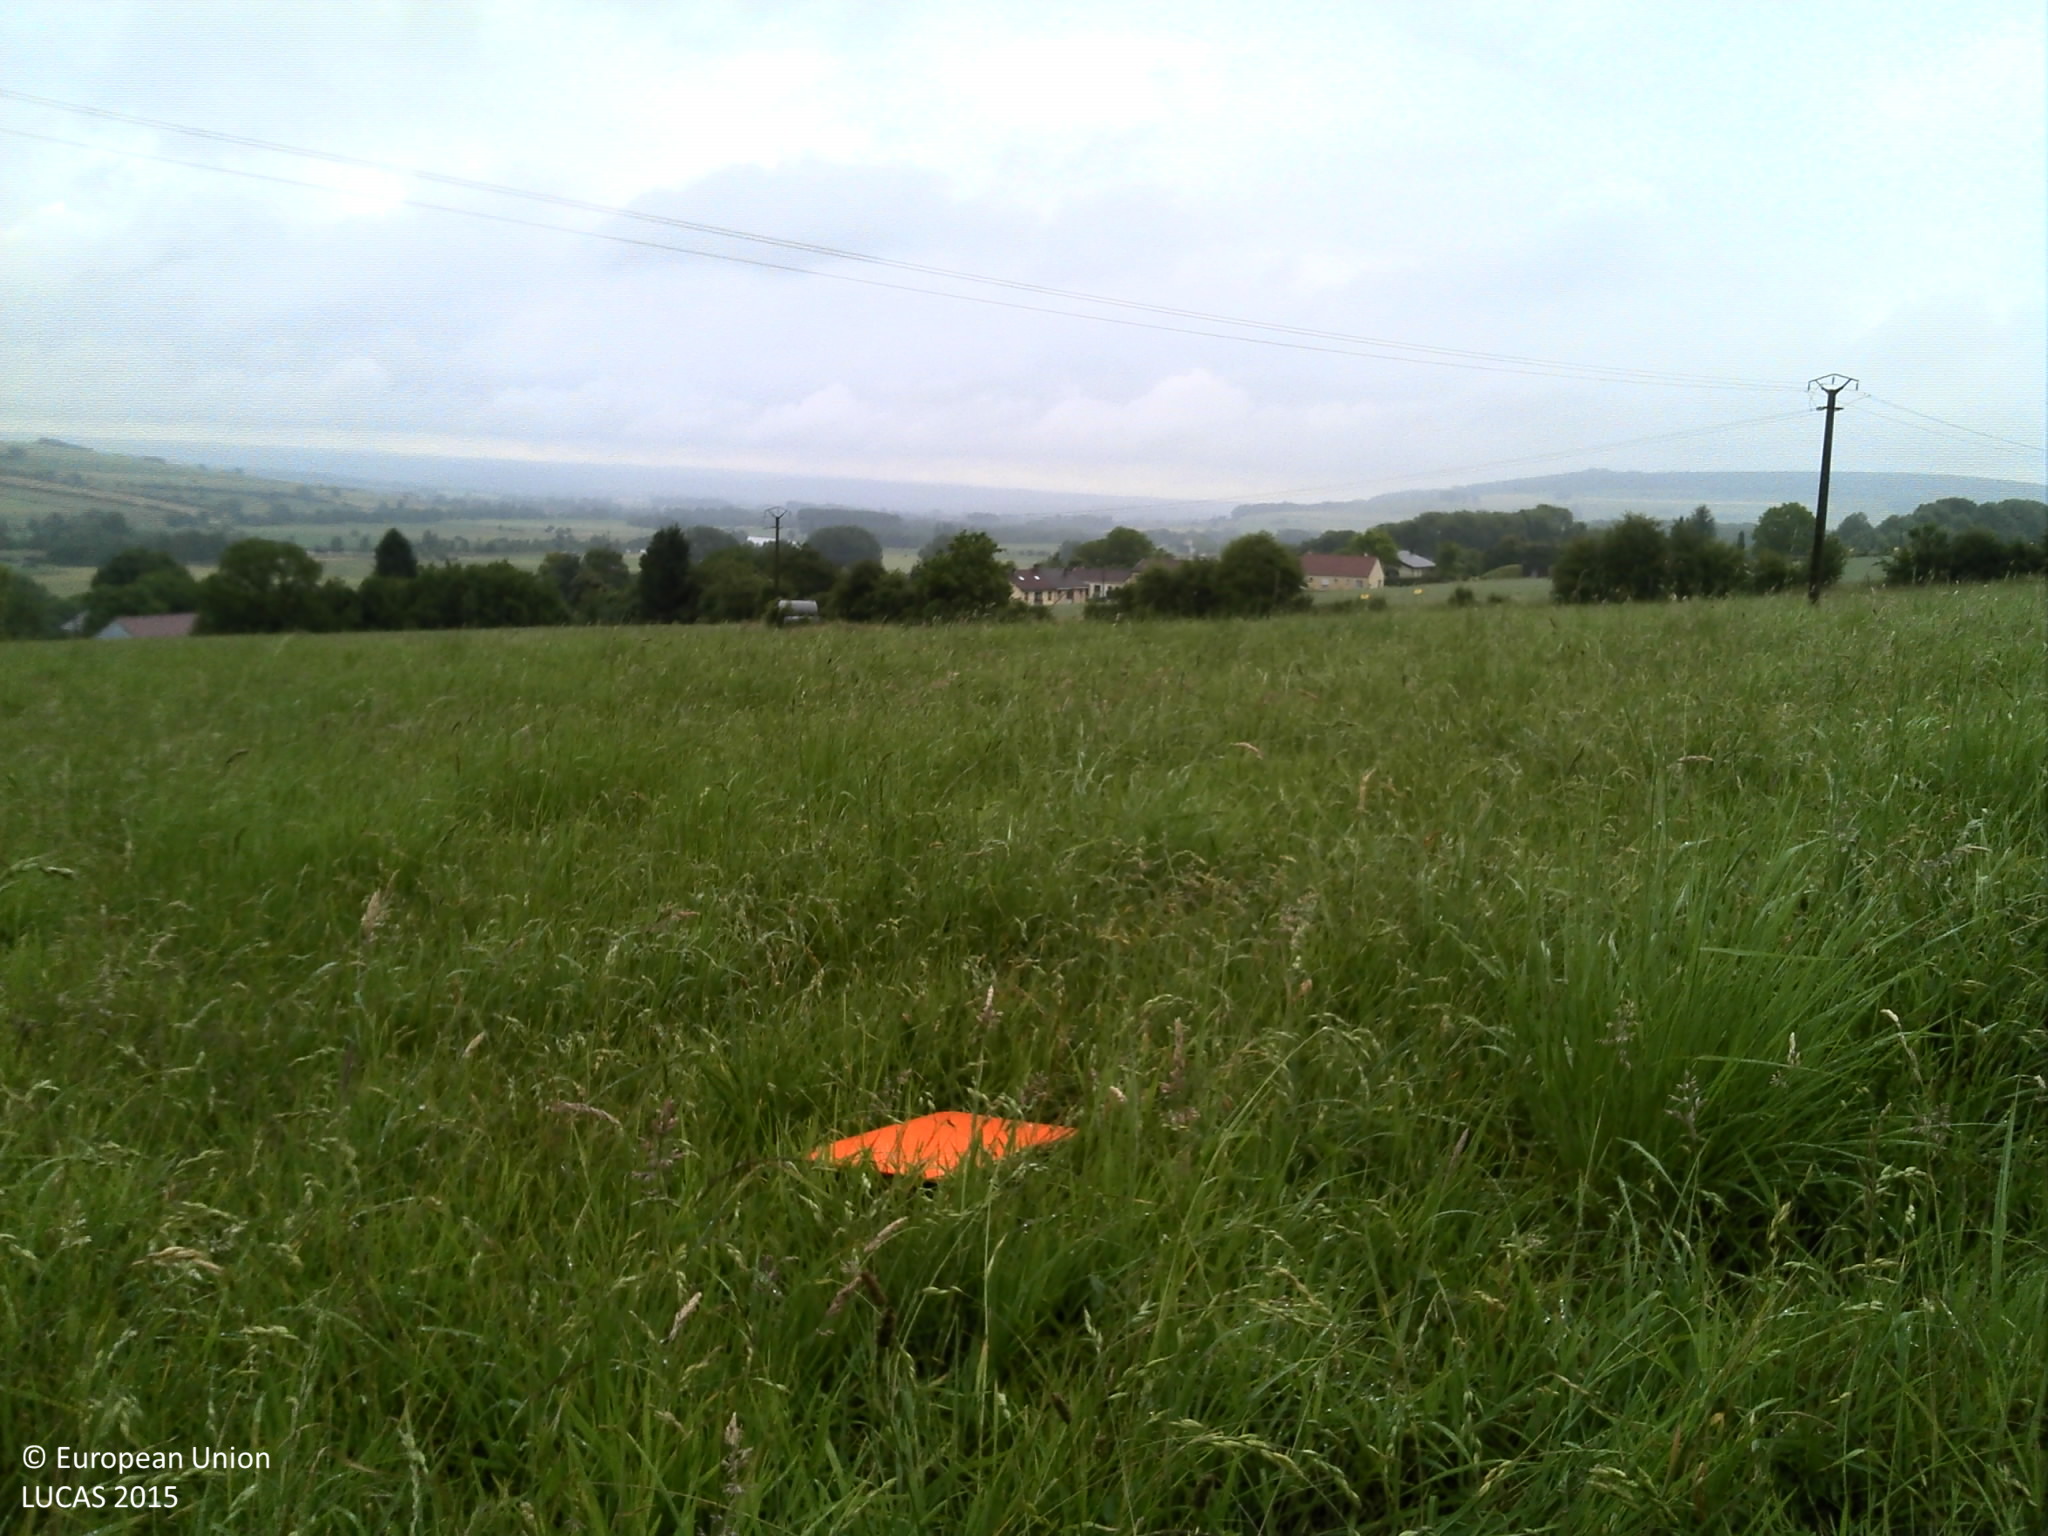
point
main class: Grassland
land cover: Grassland without tree/shrub cover
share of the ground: > 75 %
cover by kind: herbaceous plants 100 %
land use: Agriculture (excluding fallow land and kitchen gardens)
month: June
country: FR
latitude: 49.6872
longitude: 4.7990
